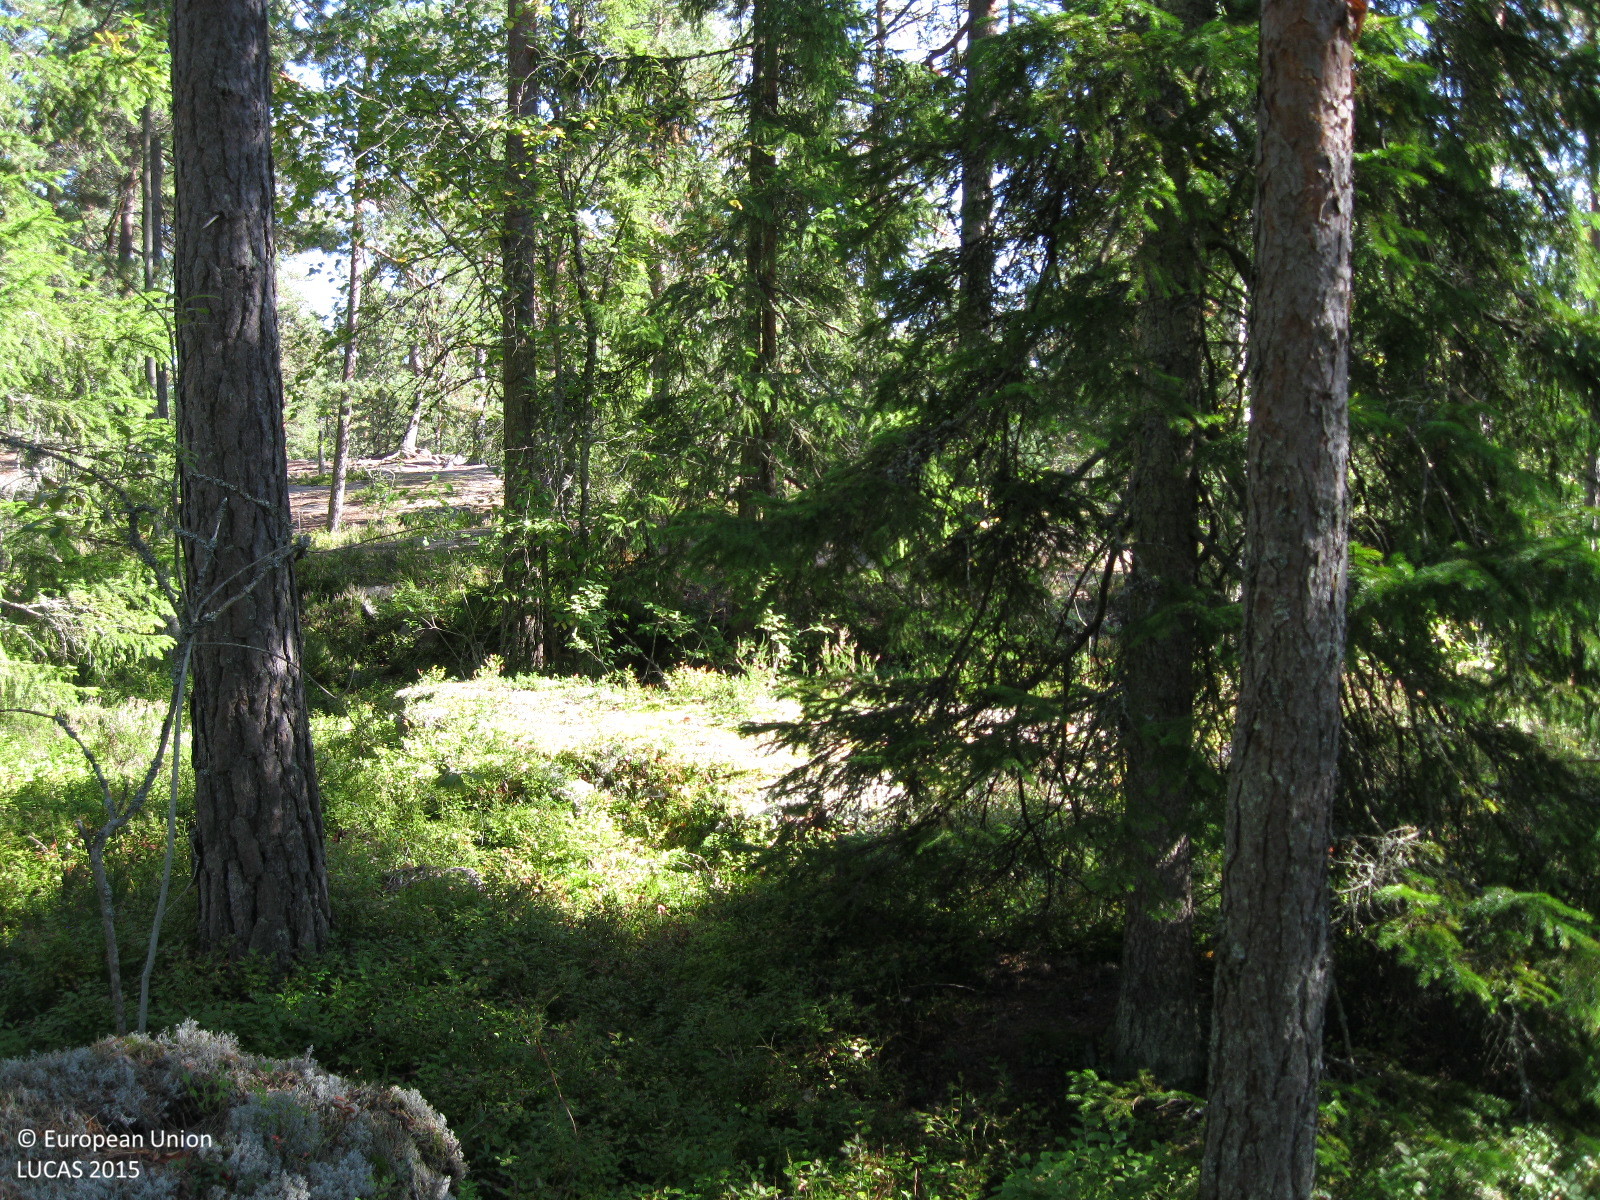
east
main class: Woodland
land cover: Pine dominated coniferous woodland
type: boreal forest
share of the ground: 50 - 75 %
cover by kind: coniferous forest trees 65 %, shrubs 15 %, herbaceous plants 15 %, broadleaved forest trees 5 %
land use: Forestry
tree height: > 5 m
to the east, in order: Pine dominated coniferous woodland; Tracks; Pine dominated coniferous woodland; Spruce dominated coniferous woodland; Other mixed woodland; Grassland with sparse tree/shrub cover; Electric lines
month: September
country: FI
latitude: 60.6320
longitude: 24.9026
